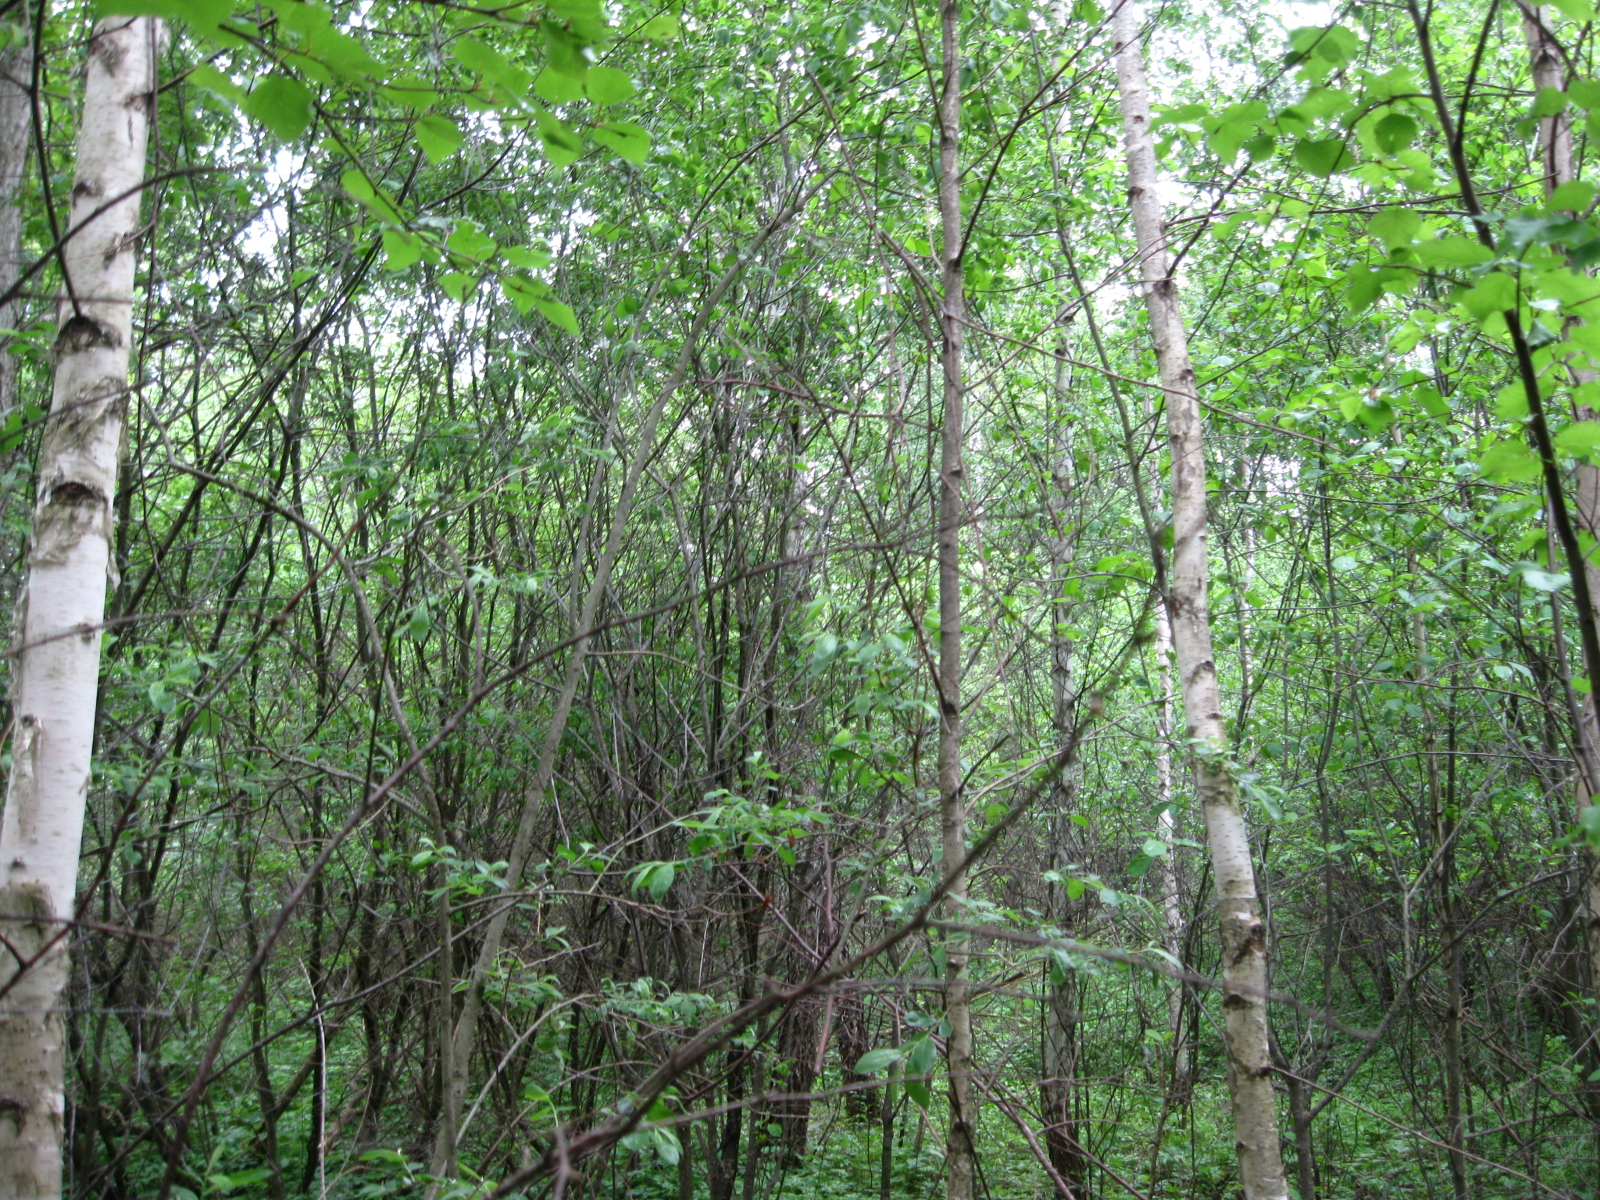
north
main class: Woodland
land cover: Broadleaved woodland
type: non-riverine alder, birch or aspen forest
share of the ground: > 75 %
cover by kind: broadleaved forest trees 80 %, herbaceous plants 15 %, shrubs 5 %
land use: Forestry
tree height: > 5 m
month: June
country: LT
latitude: 55.9169
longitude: 24.0898
